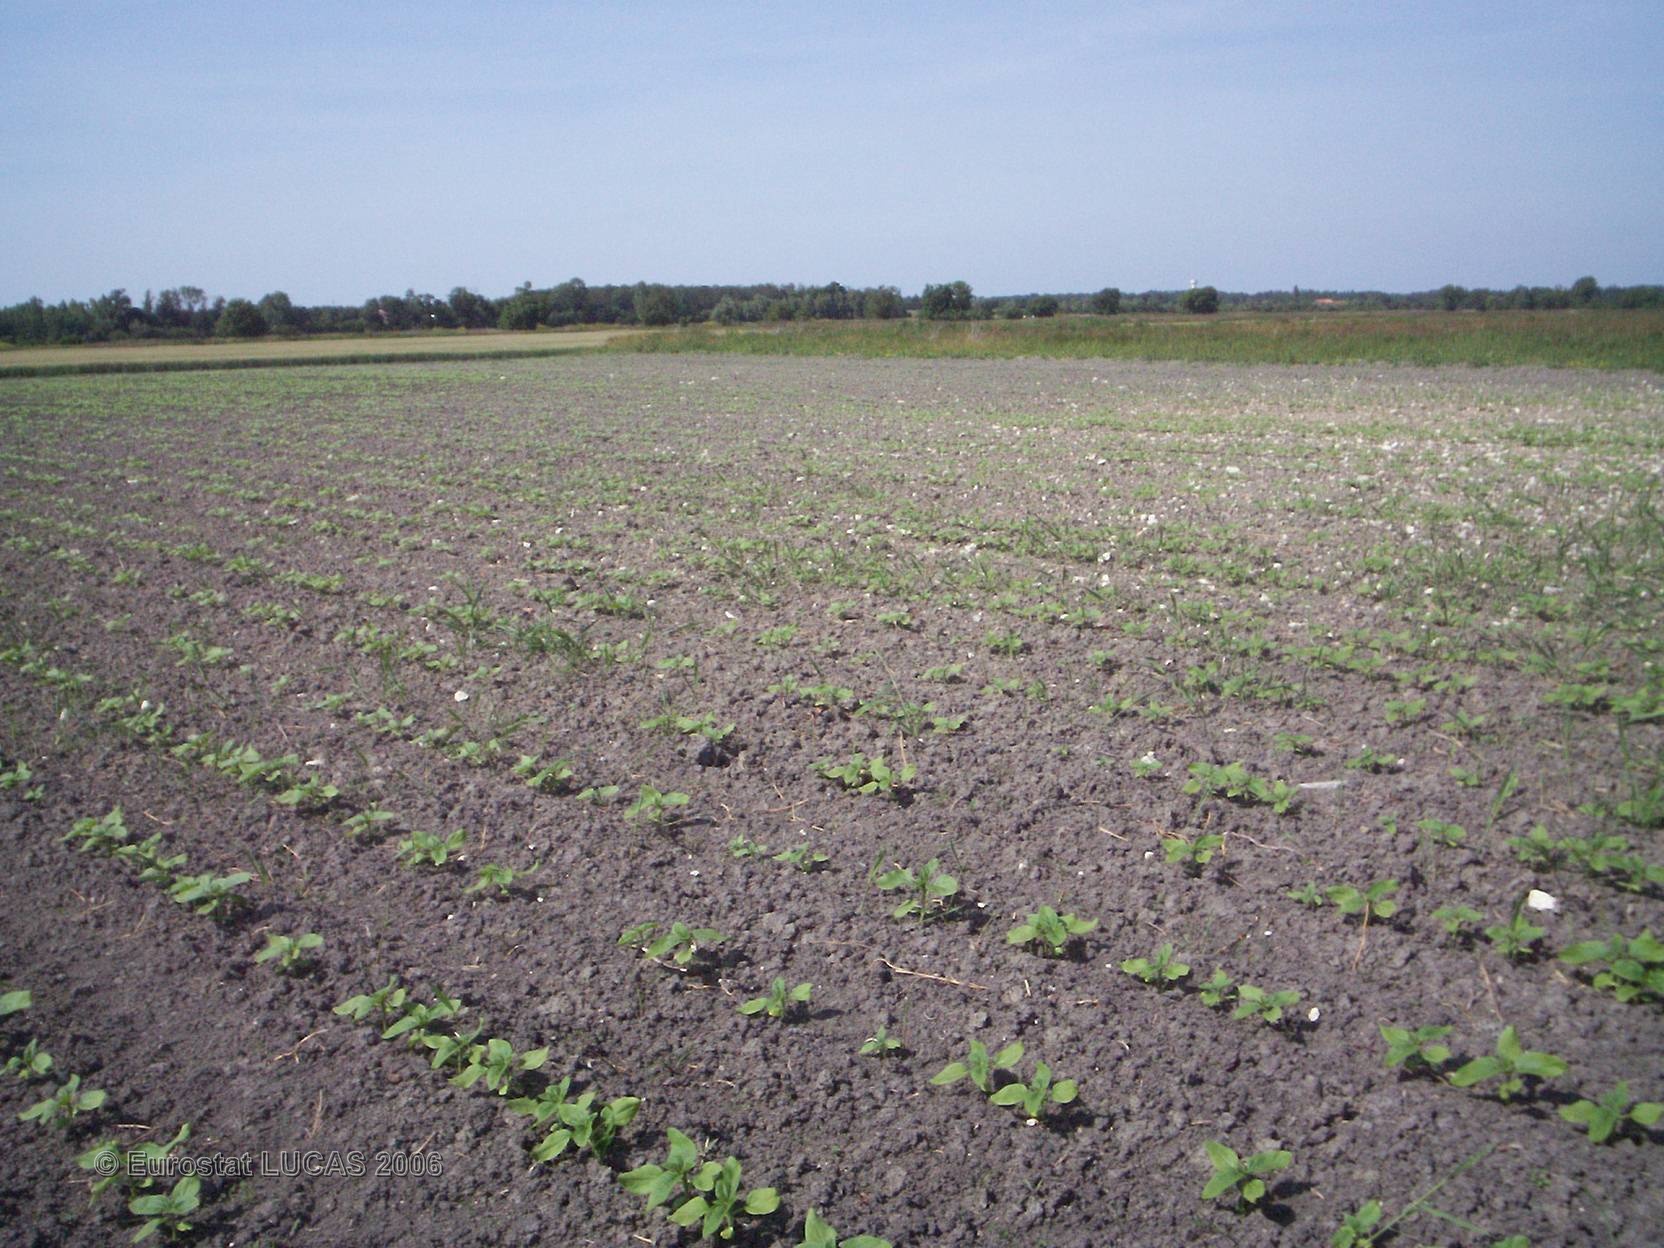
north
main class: Cropland
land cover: Sunflower
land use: Agriculture (excluding fallow land and kitchen gardens)
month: June
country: FR
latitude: 45.7003
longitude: -1.0867
